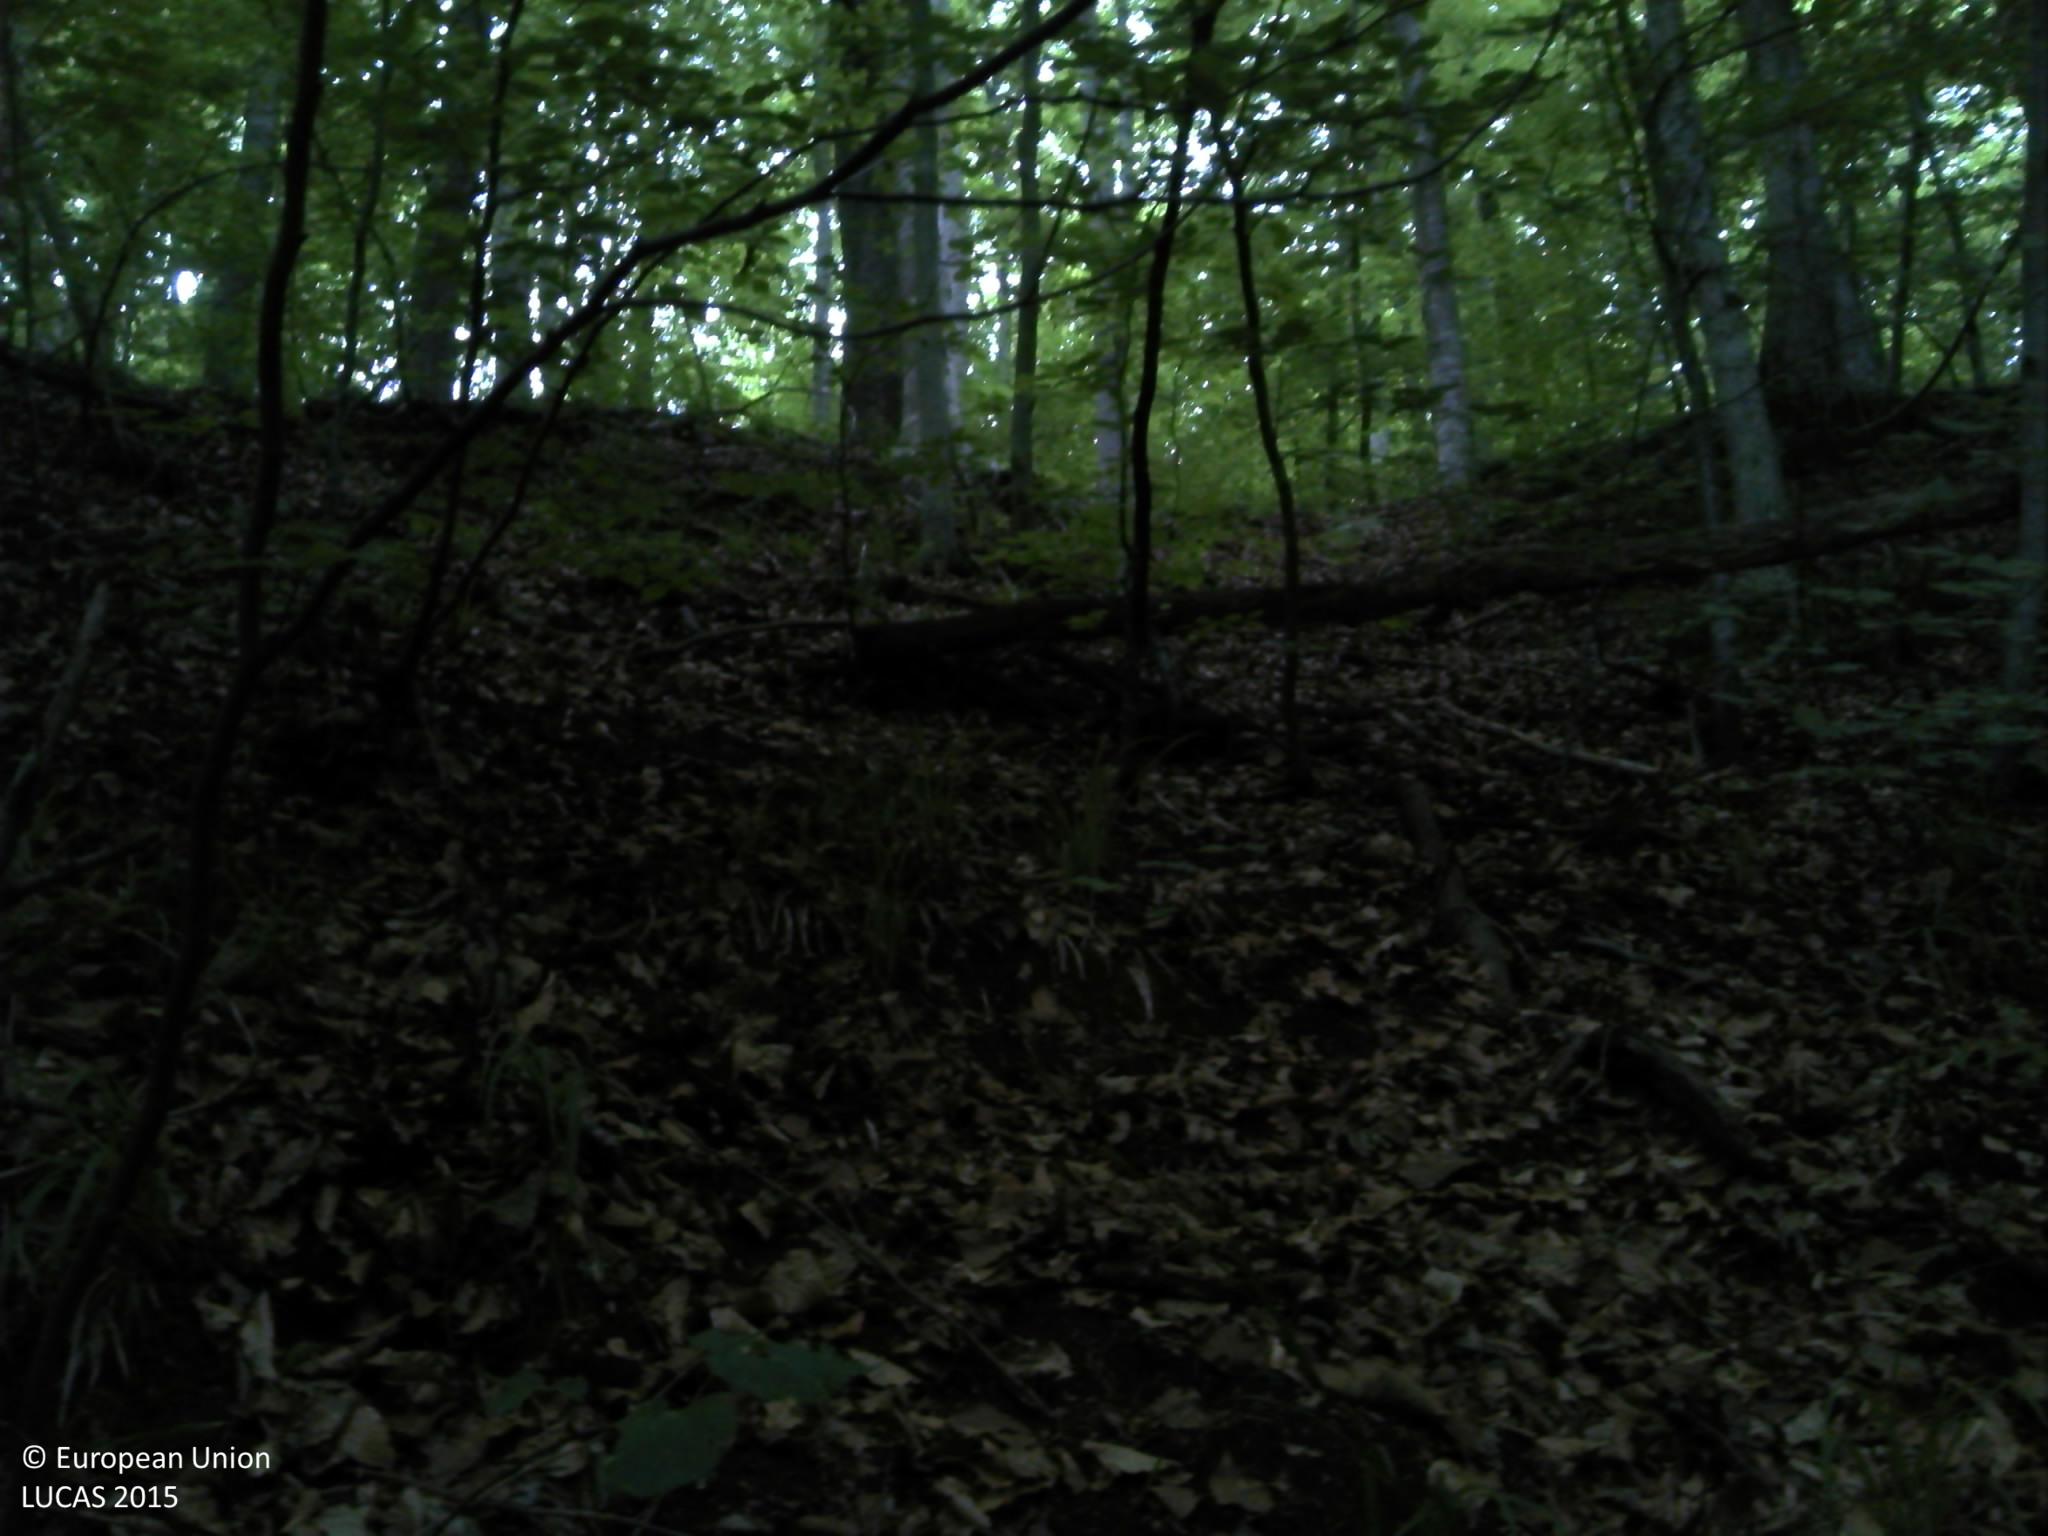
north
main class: Woodland
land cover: Broadleaved woodland
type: acidophilous oak and oak-birch forest
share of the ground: > 75 %
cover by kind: broadleaved forest trees 100 %
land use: Forestry
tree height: > 5 m
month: June
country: HR
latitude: 45.5257
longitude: 17.5173
